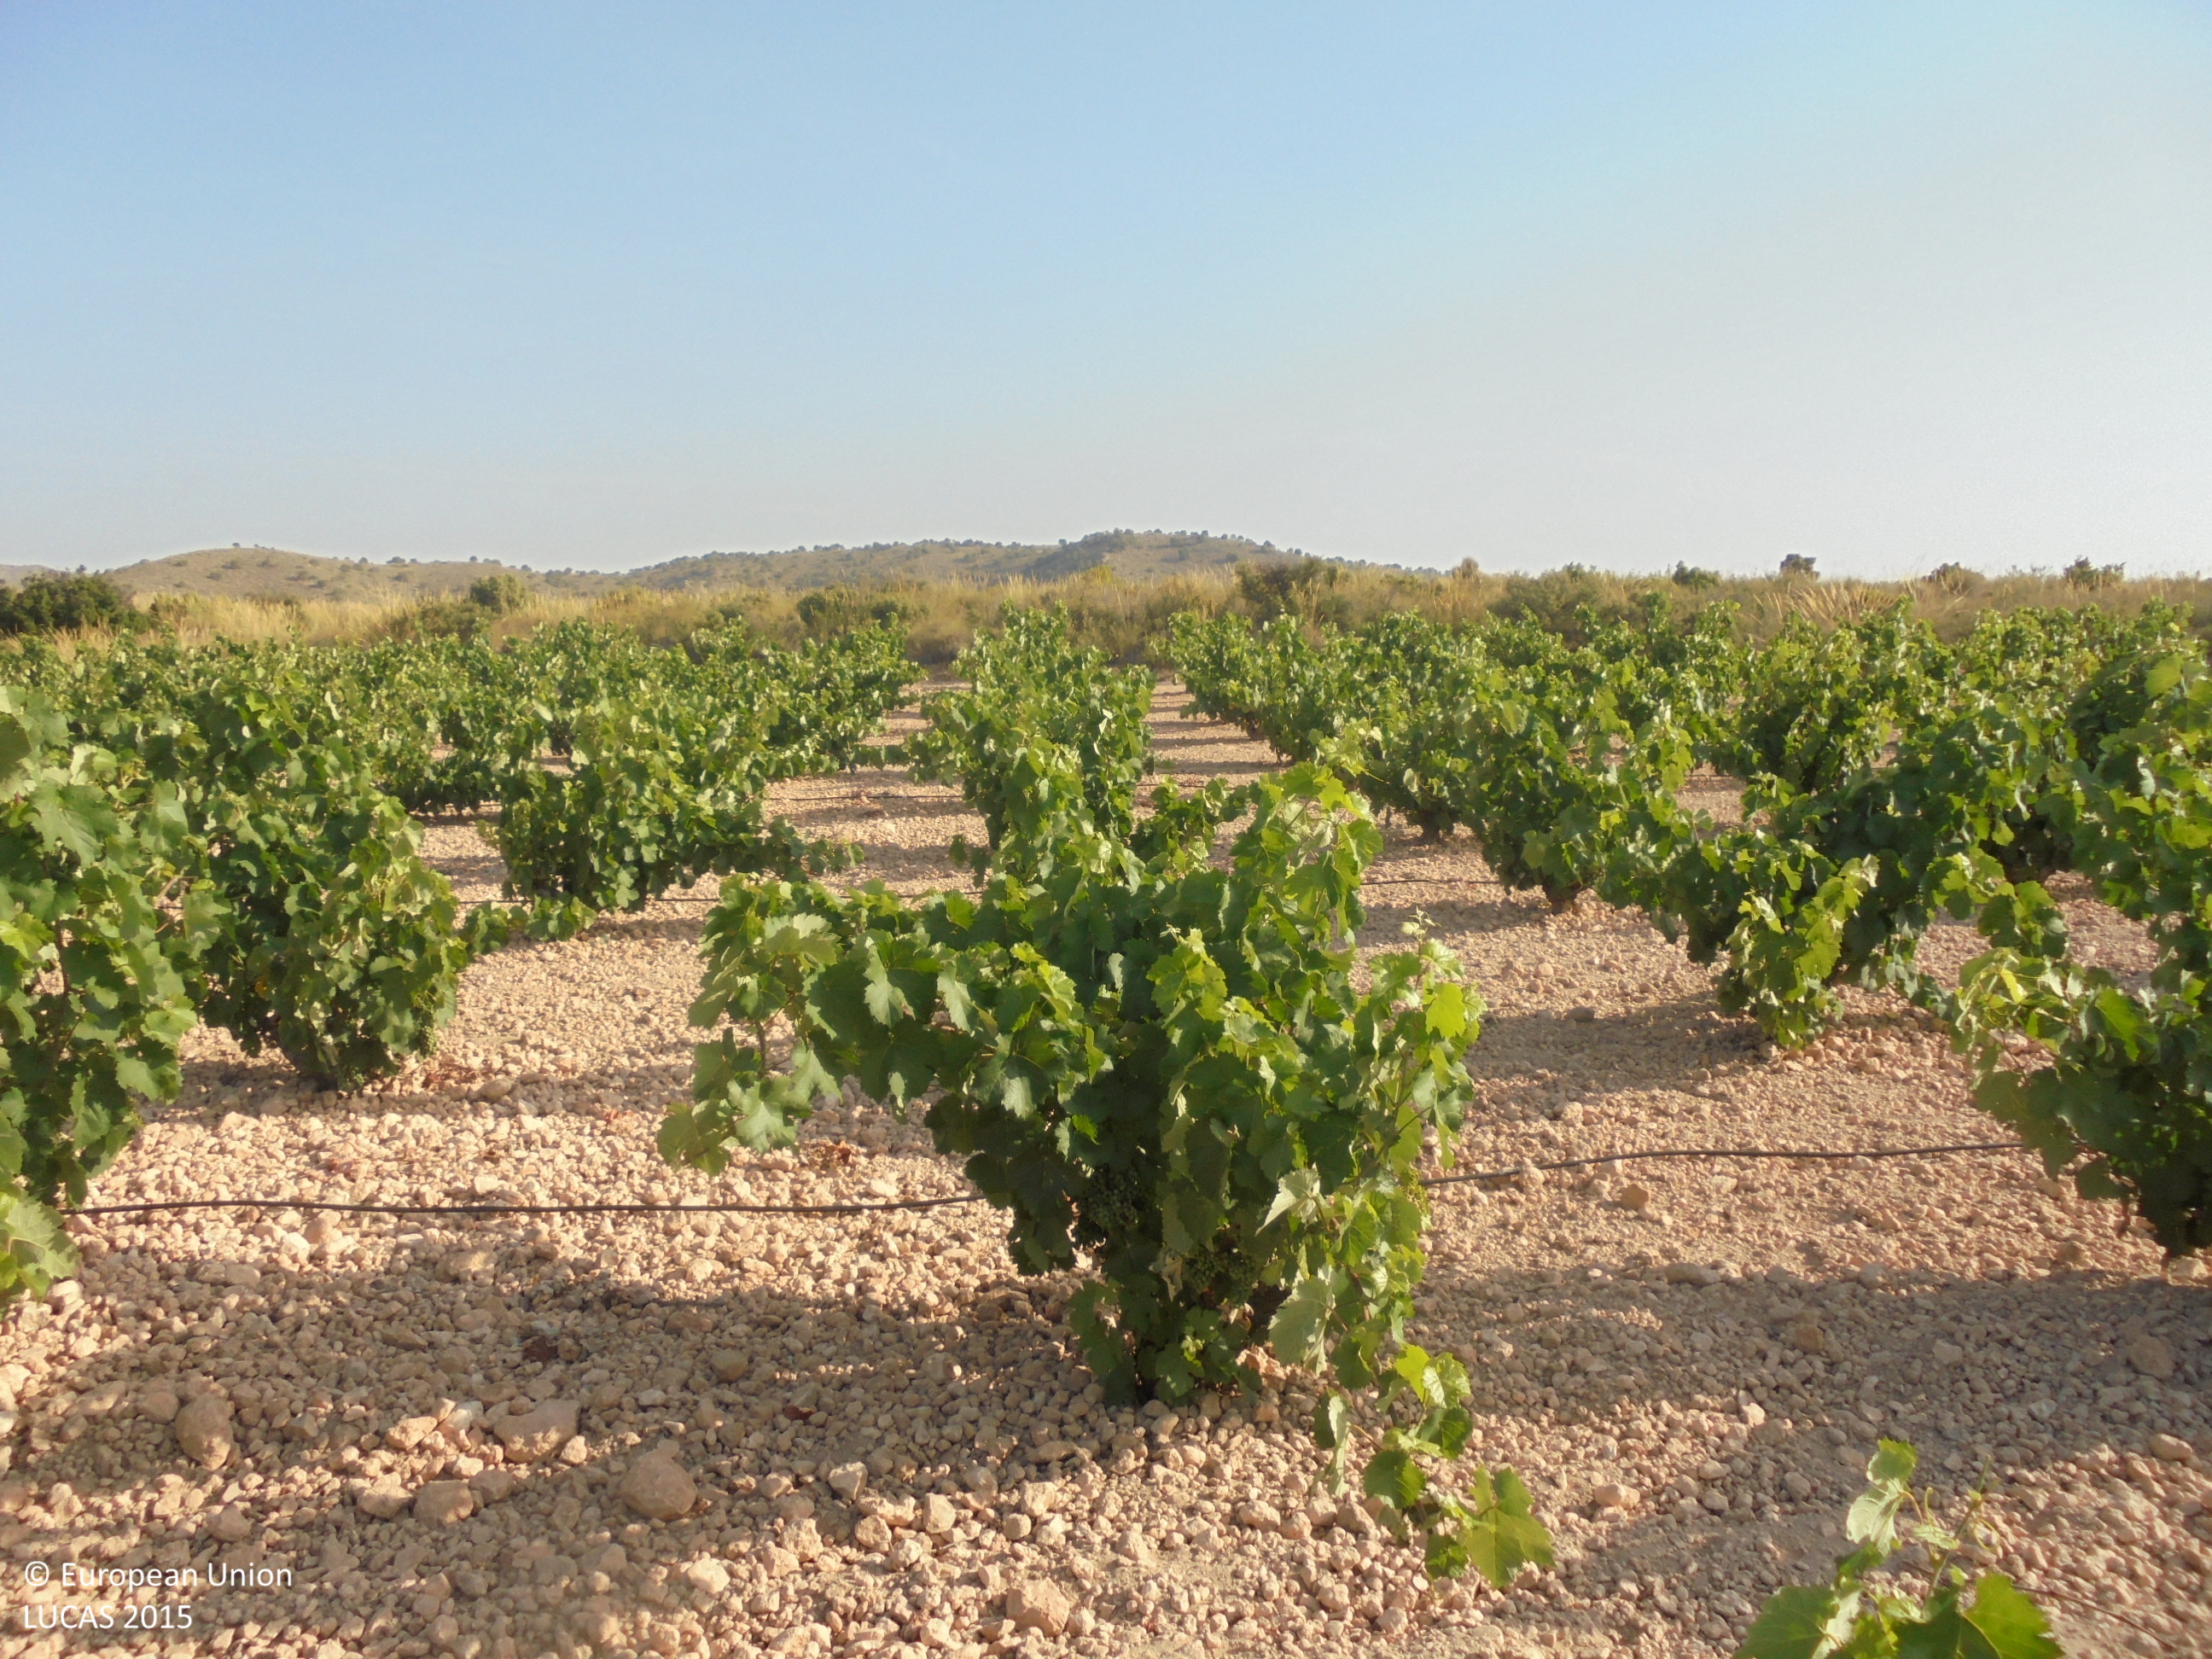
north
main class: Cropland
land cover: Vineyards
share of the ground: 25 - 50 %
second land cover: Other bare soil
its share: > 75 %
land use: Agriculture (excluding fallow land and kitchen gardens)
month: July
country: ES
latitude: 38.6437
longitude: -1.6101
